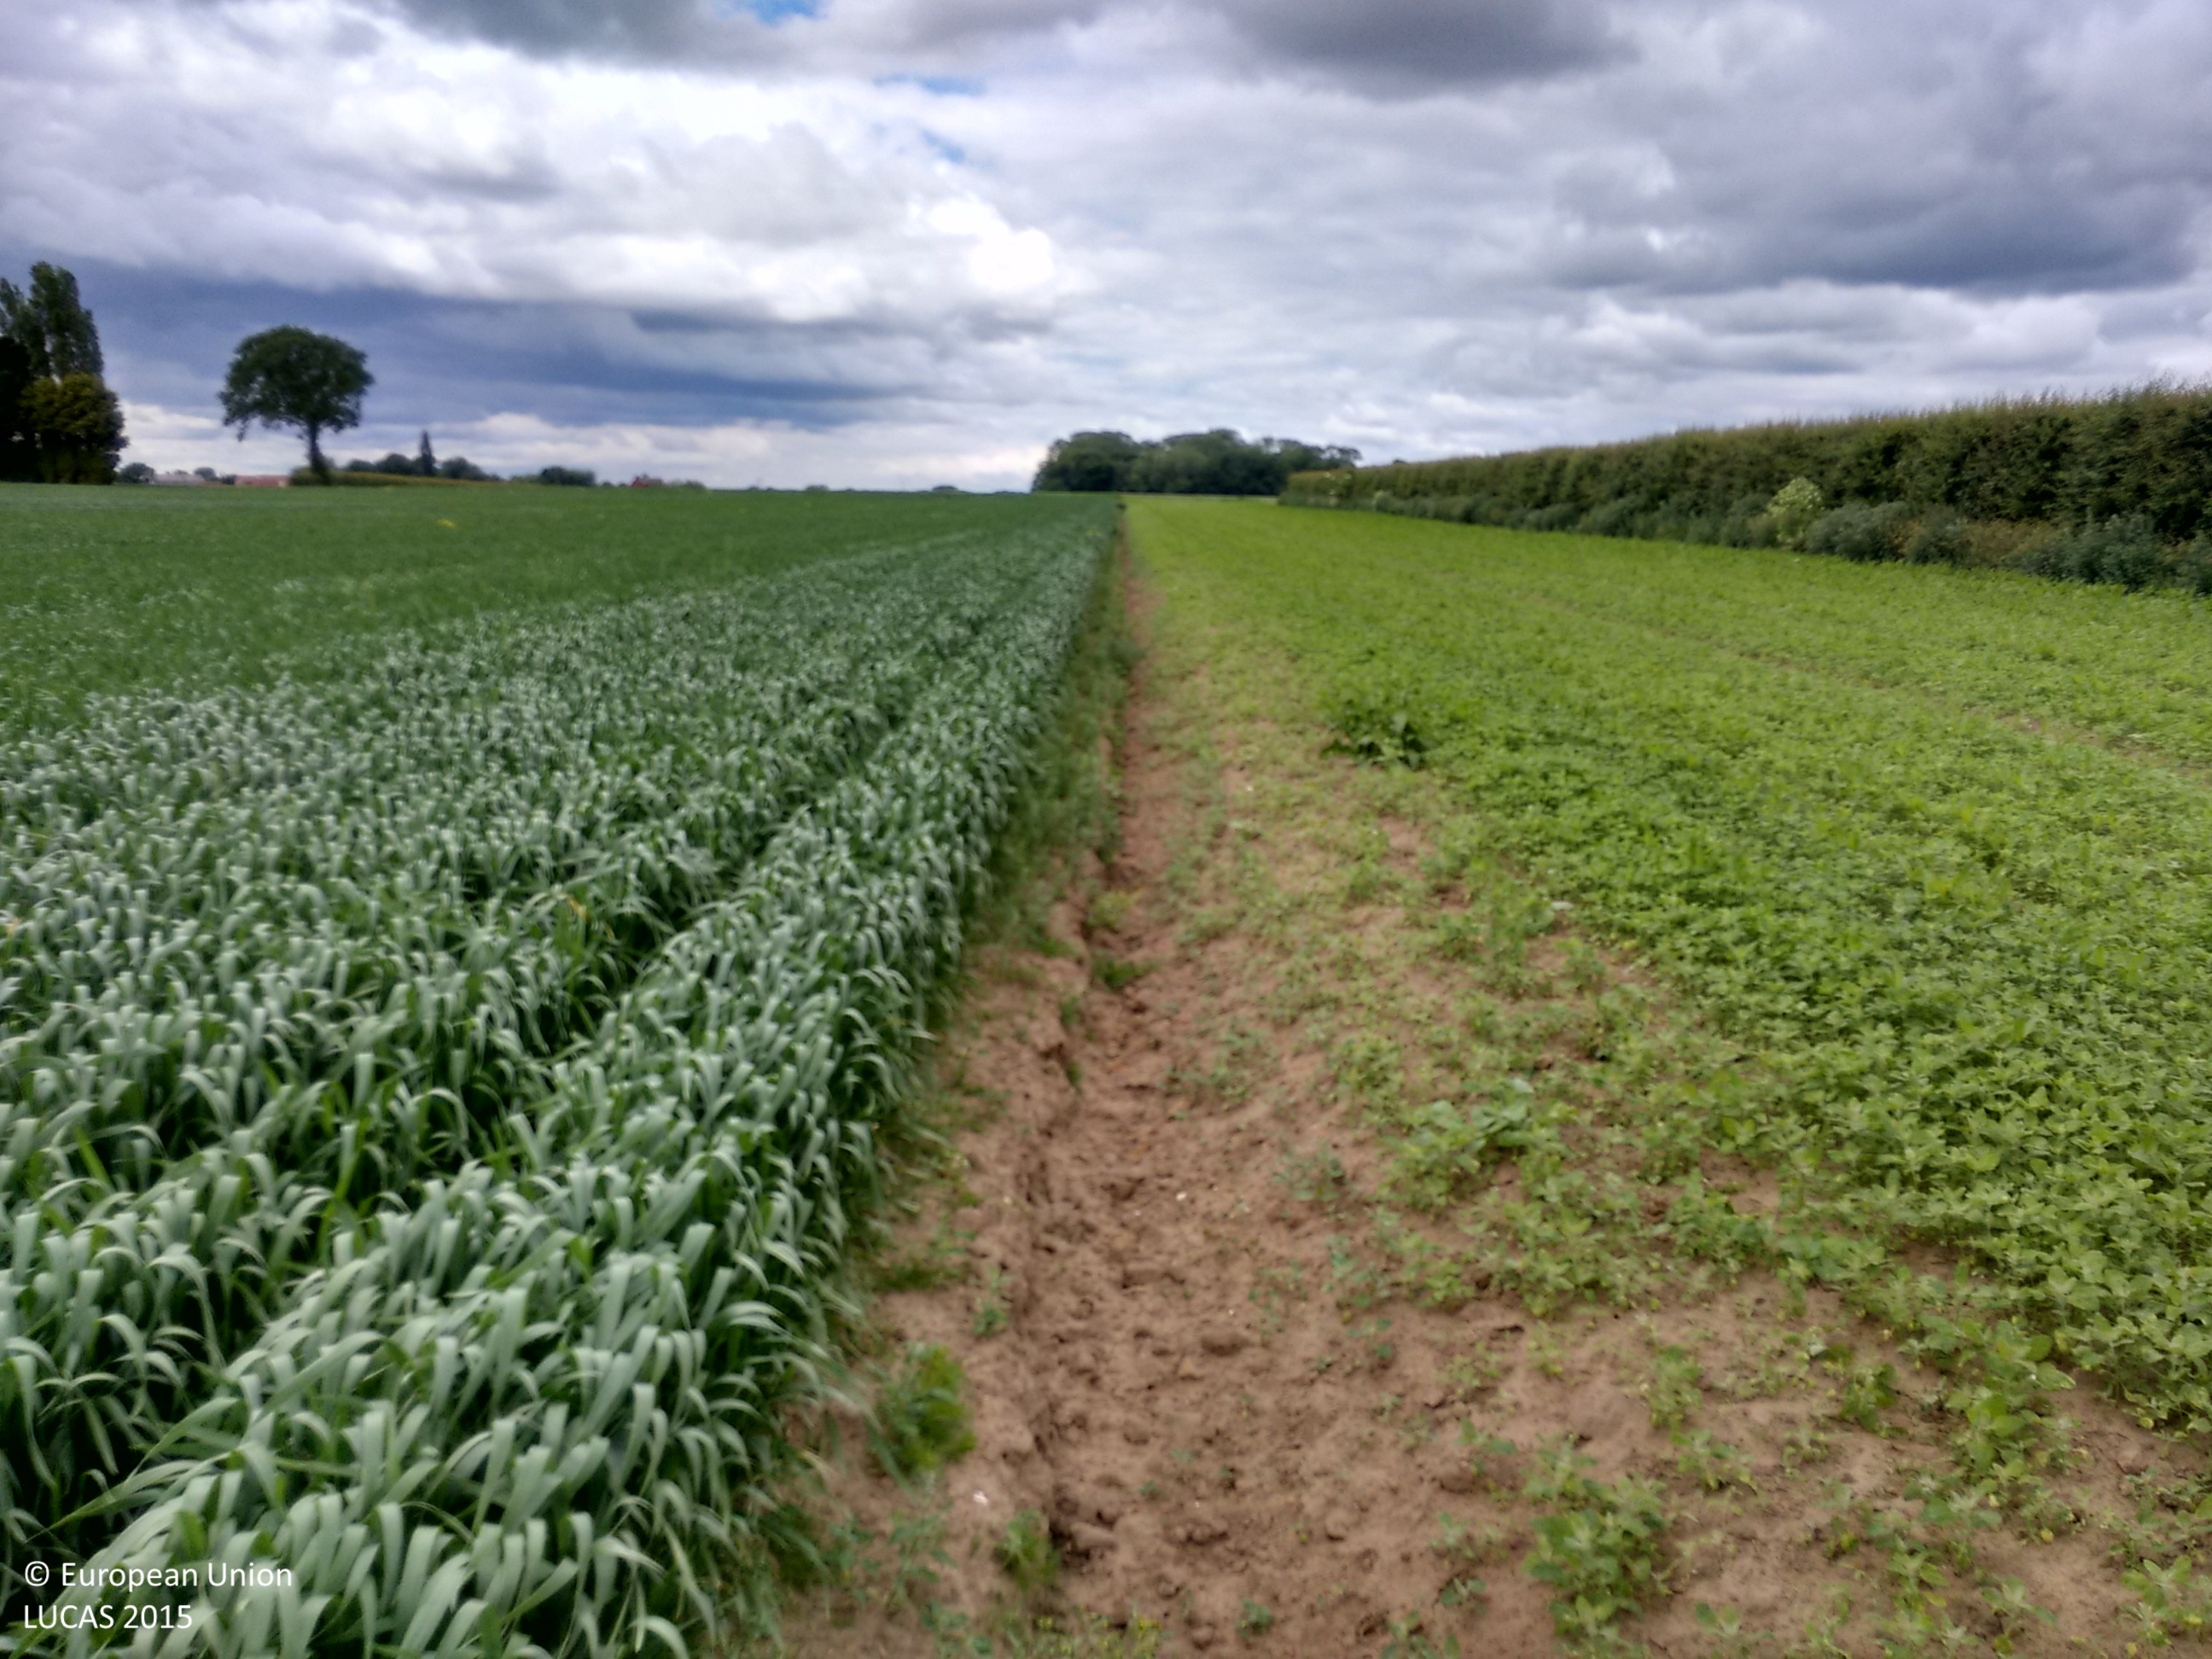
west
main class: Cropland
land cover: Common wheat
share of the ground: > 75 %
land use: Agriculture (excluding fallow land and kitchen gardens)
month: June
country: GB
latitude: 53.7461
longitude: -1.0678
